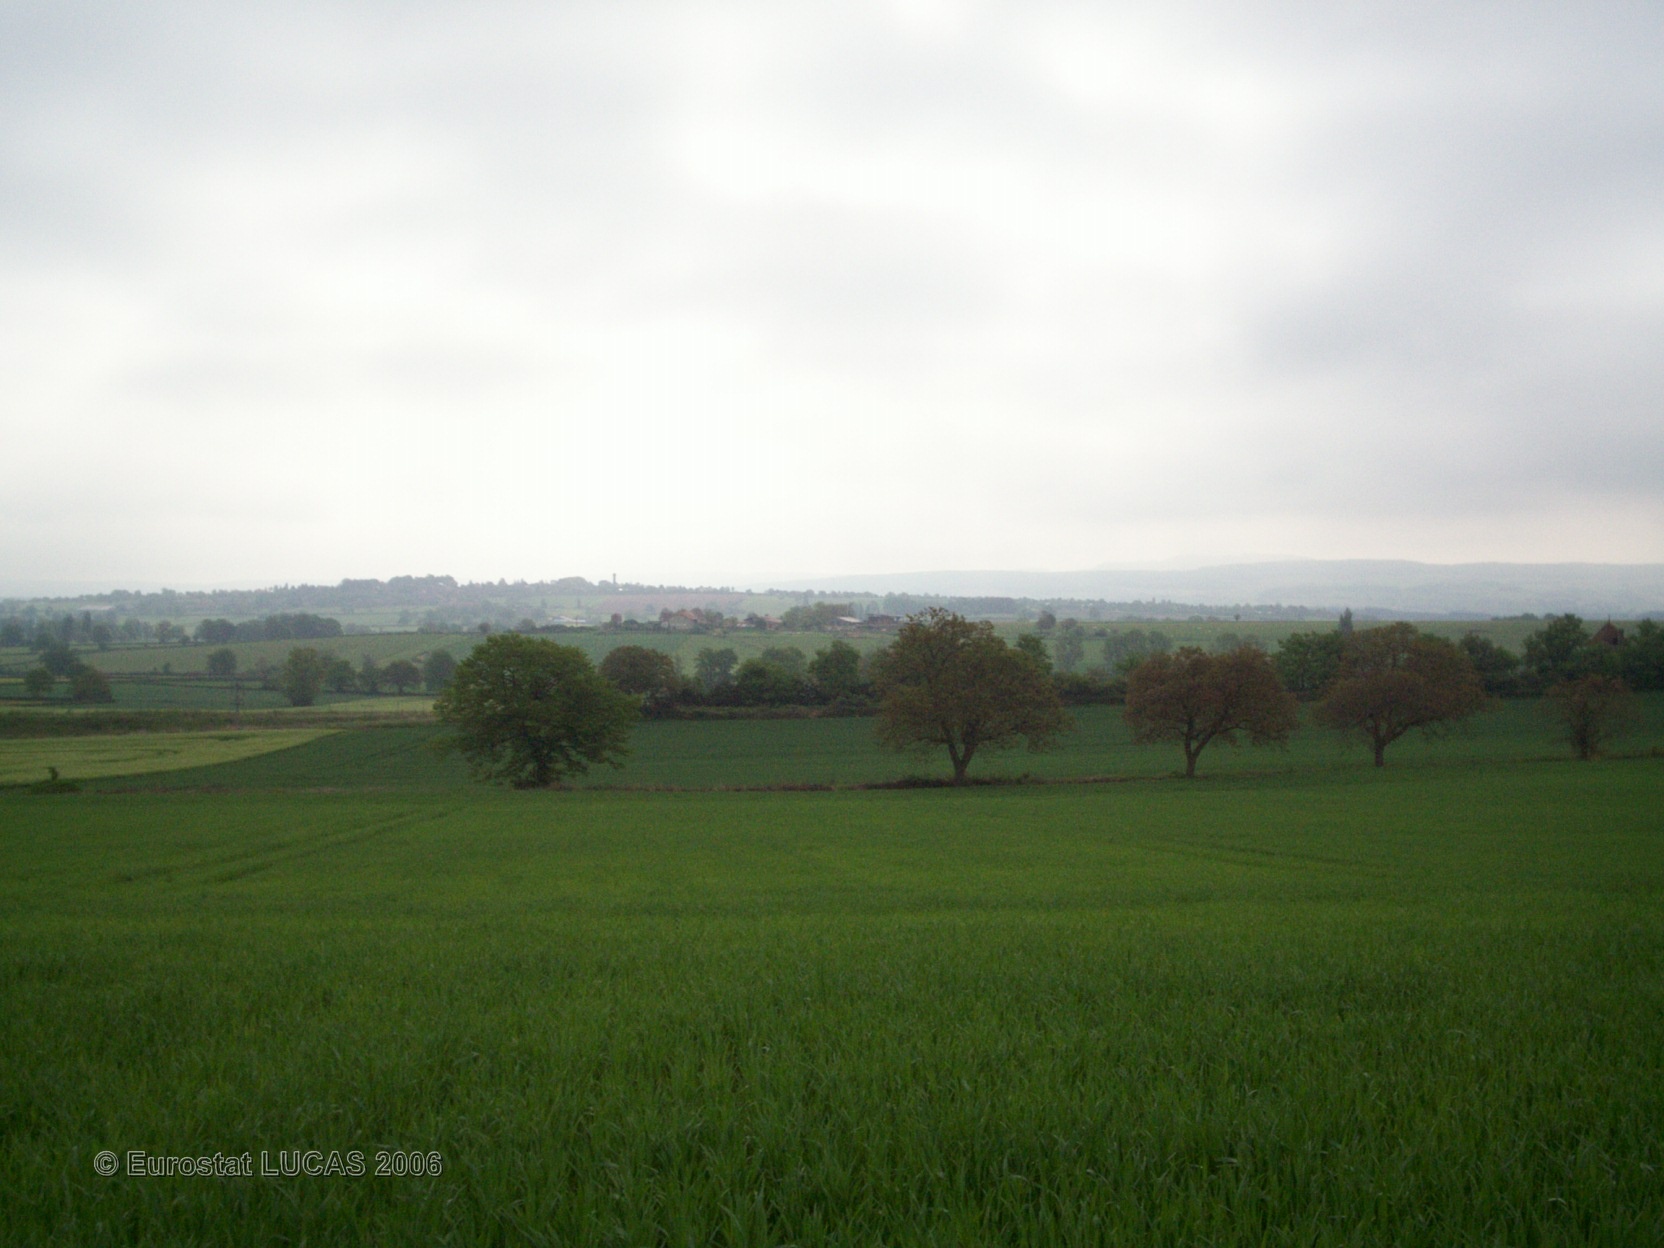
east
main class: Cropland
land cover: Common wheat
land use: Agriculture (excluding fallow land and kitchen gardens)
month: May
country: FR
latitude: 46.5239
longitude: 4.6437
